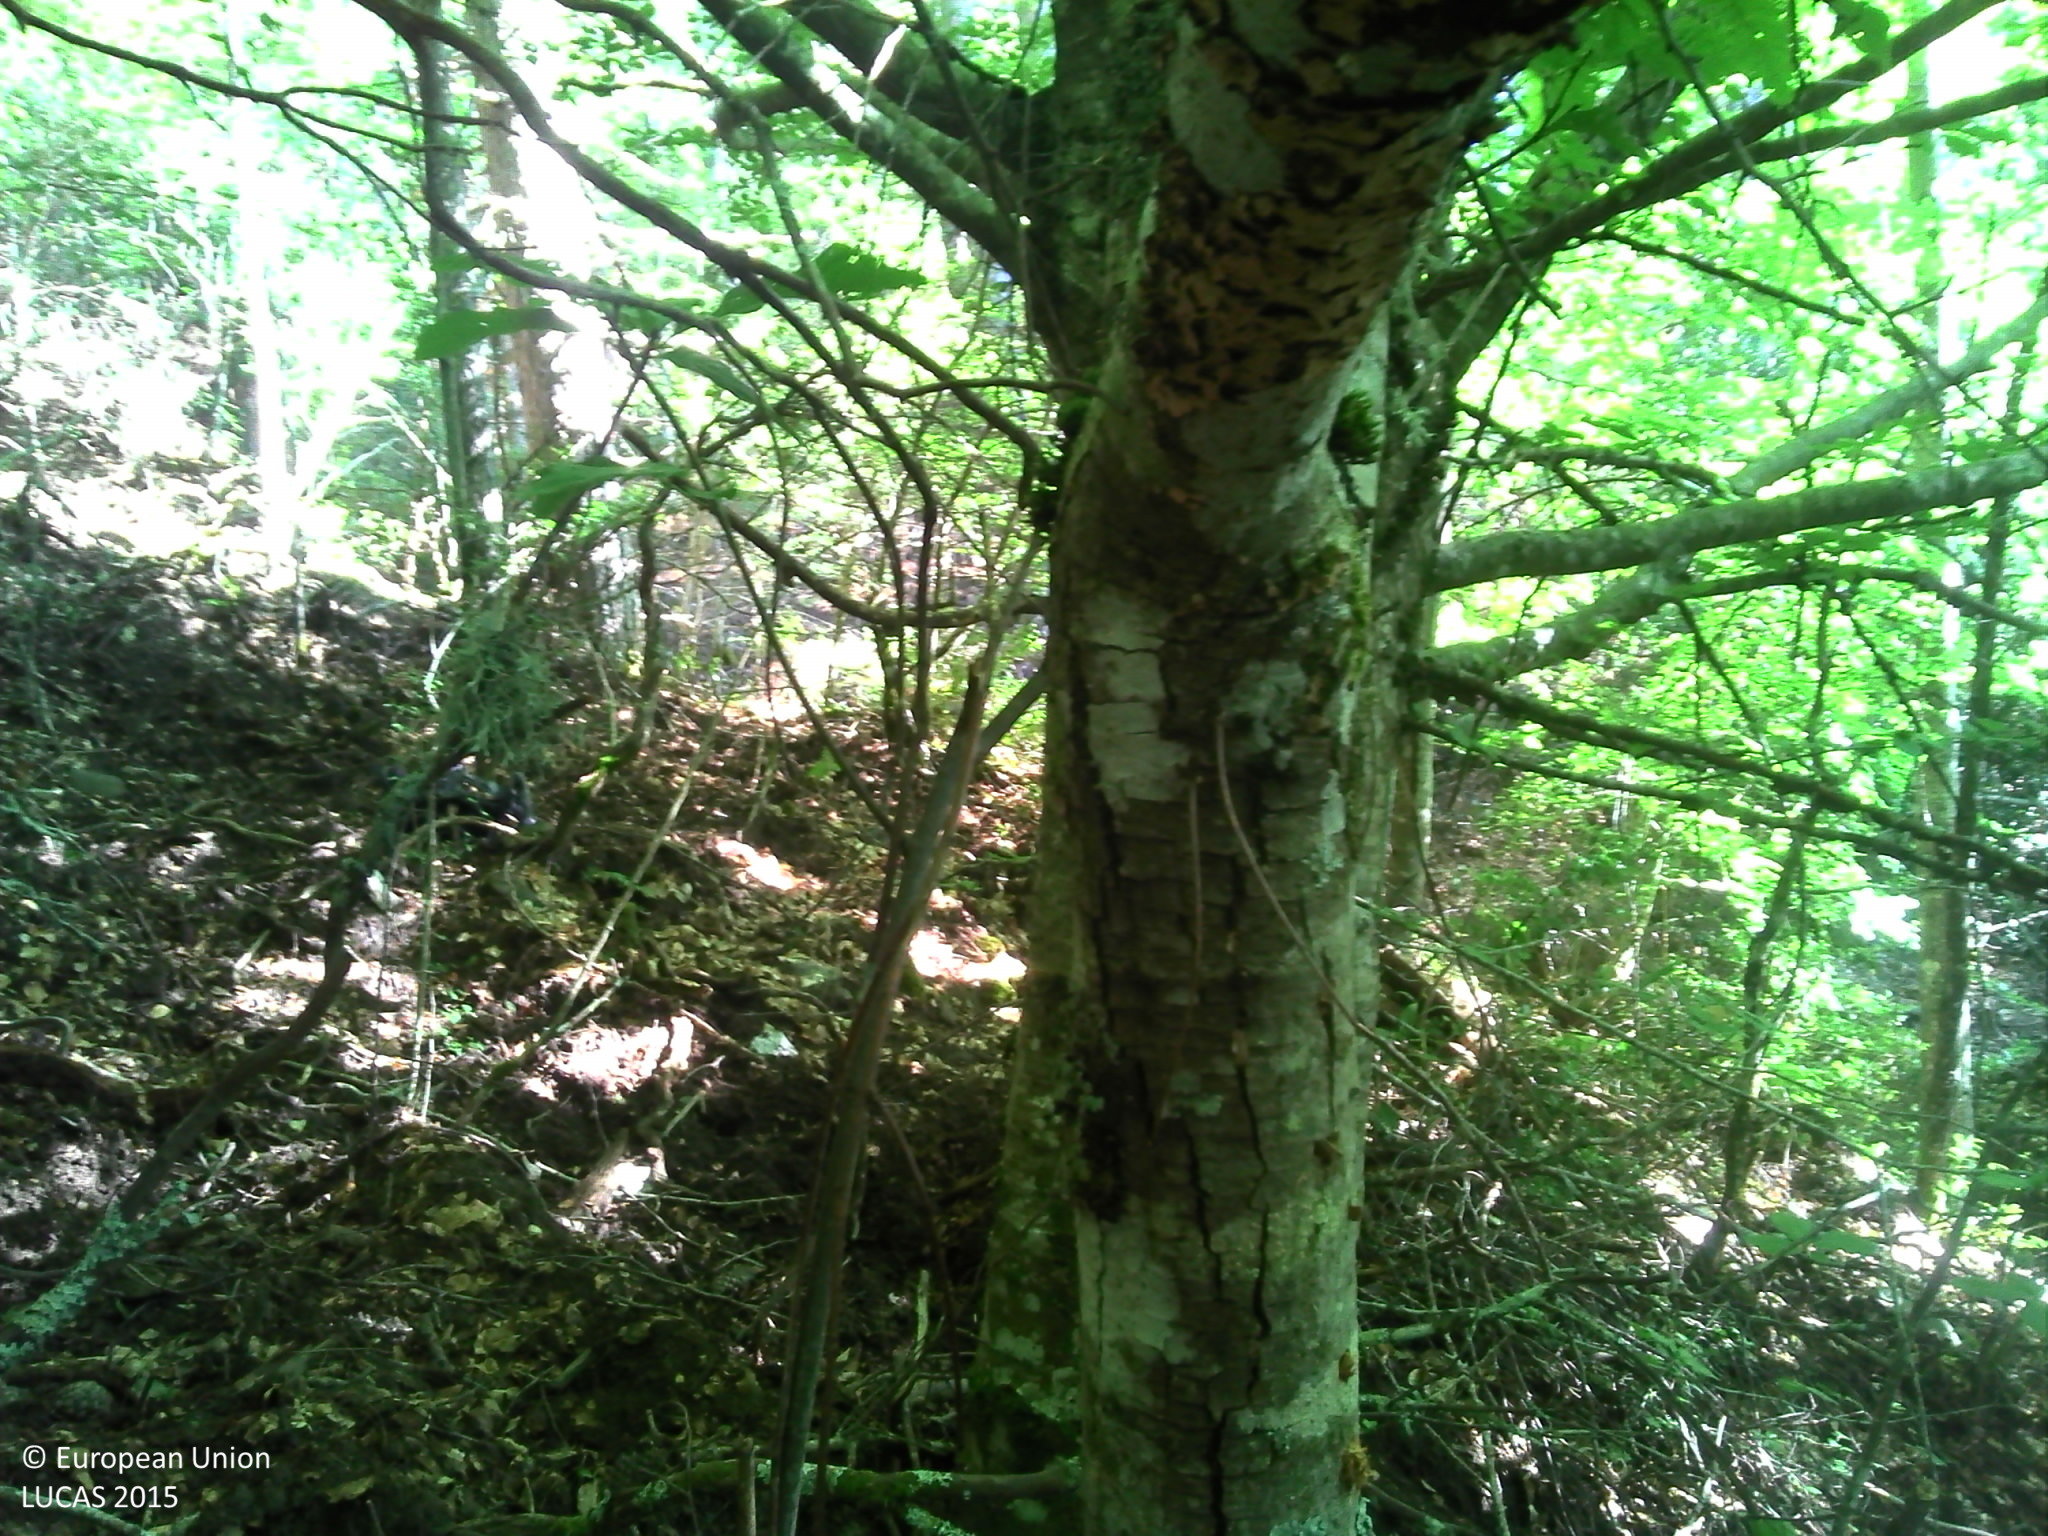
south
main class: Woodland
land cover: Broadleaved woodland
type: mountainous beech forest
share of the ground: > 75 %
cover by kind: broadleaved forest trees 100 %
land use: Forestry
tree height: > 5 m
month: June
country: FR
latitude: 42.2904
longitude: 9.3112
